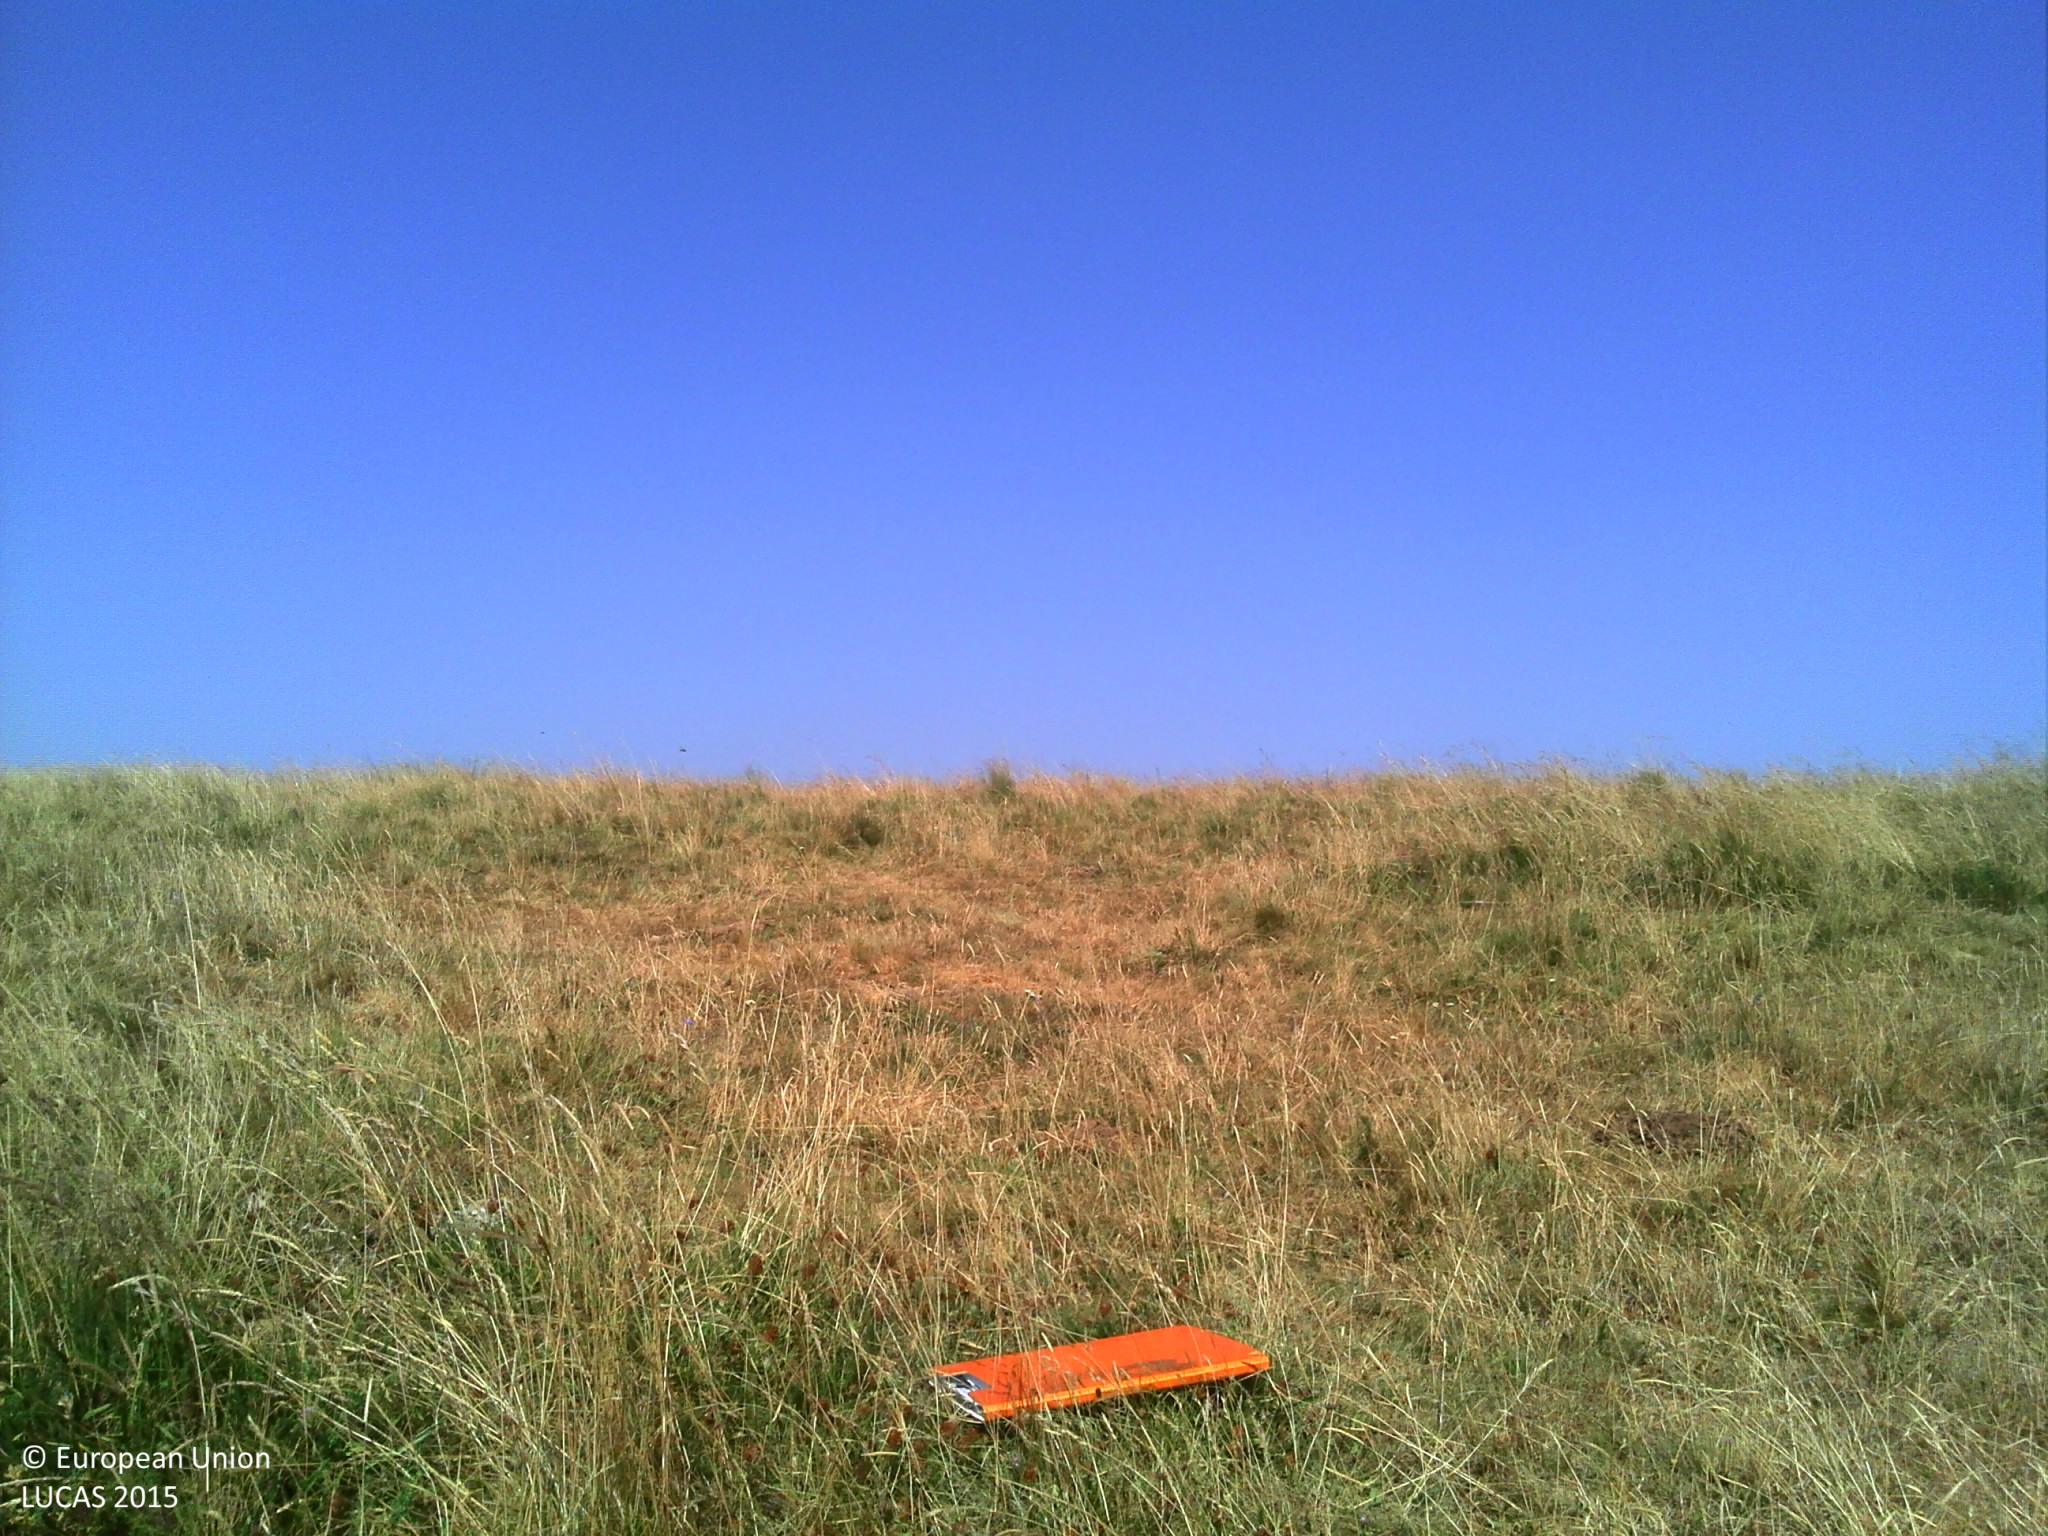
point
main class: Grassland
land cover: Grassland without tree/shrub cover
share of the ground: > 75 %
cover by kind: herbaceous plants 95 %, shrubs 5 %
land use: Agriculture (excluding fallow land and kitchen gardens)
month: July
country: FR
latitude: 44.6084
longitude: 3.0863
